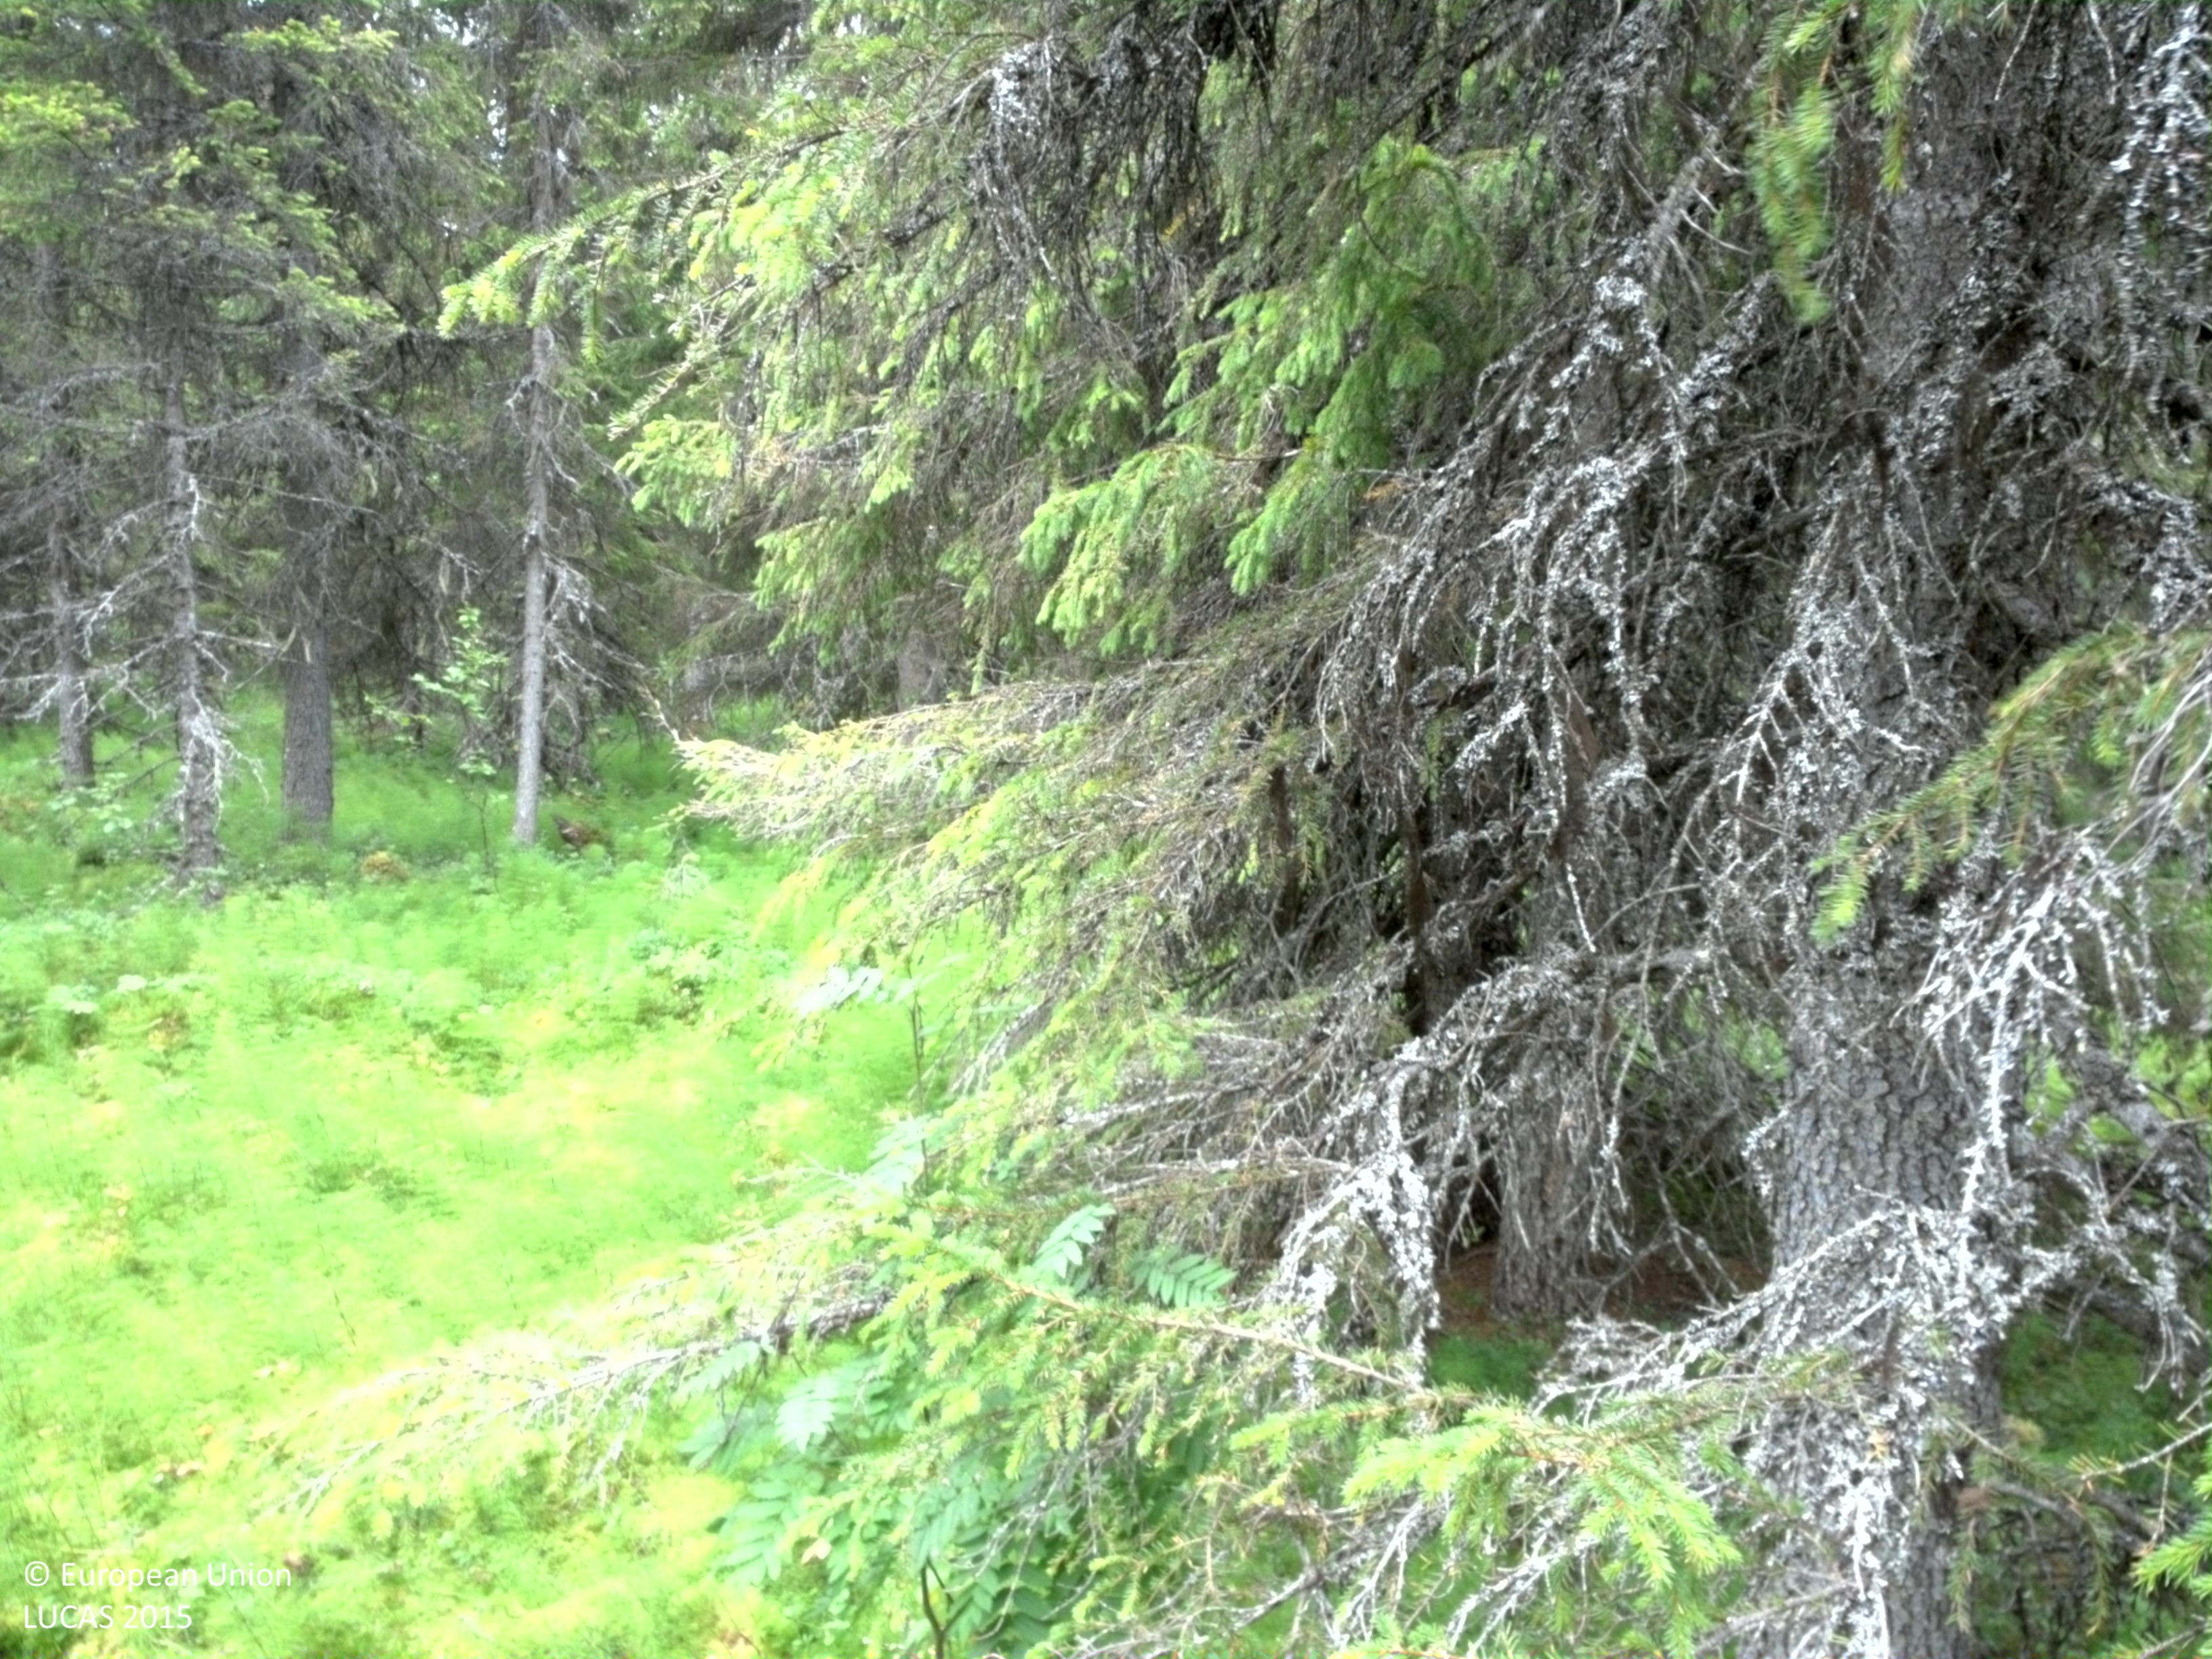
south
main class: Woodland
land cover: Spruce dominated mixed woodland
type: boreal forest
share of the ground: 25 - 50 %
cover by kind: lichens and mosses 35 %, shrubs 20 %, herbaceous plants 20 %, coniferous forest trees 15 %, broadleaved forest trees 10 %
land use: Forestry
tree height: > 5 m
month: August
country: SE
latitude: 64.8605
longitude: 16.5688
